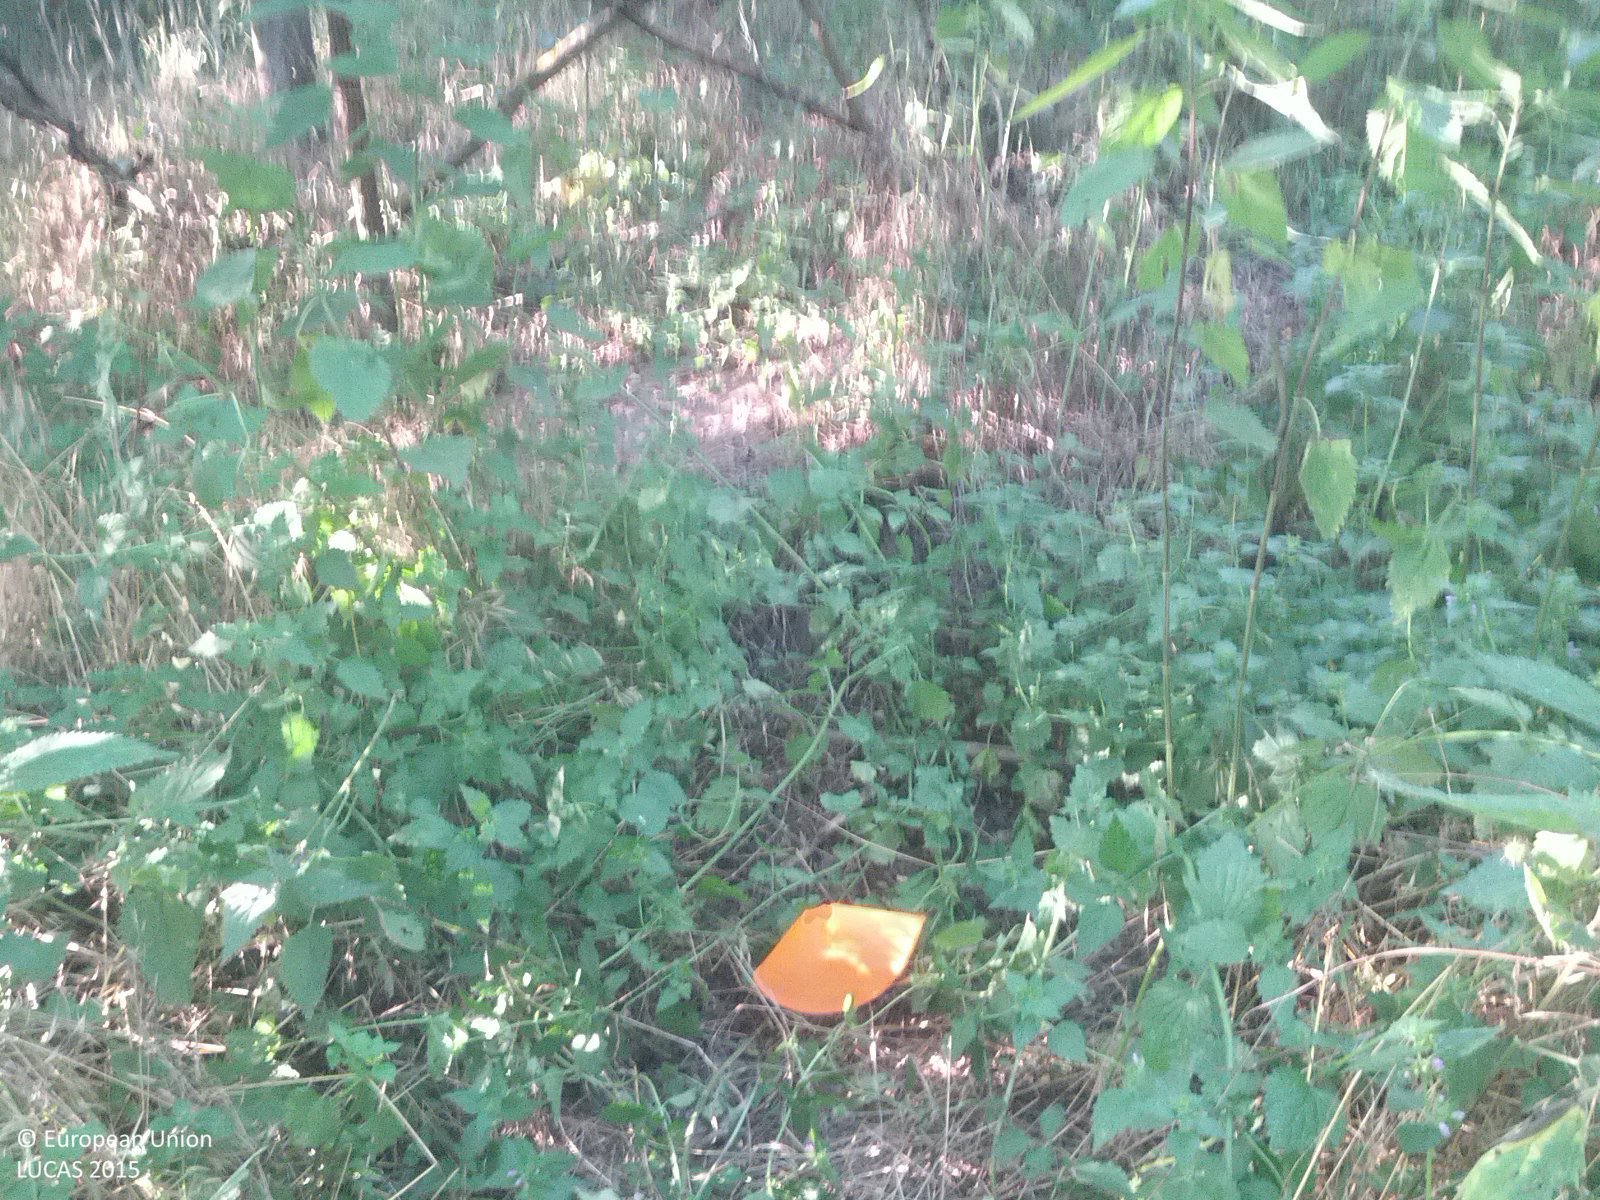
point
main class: Woodland
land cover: Broadleaved woodland
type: mesophytic deciduous forest
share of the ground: > 75 %
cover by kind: broadleaved forest trees 90 %, herbaceous plants 10 %
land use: Forestry
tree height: > 5 m
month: July
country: AT
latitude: 48.3862
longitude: 16.6095
